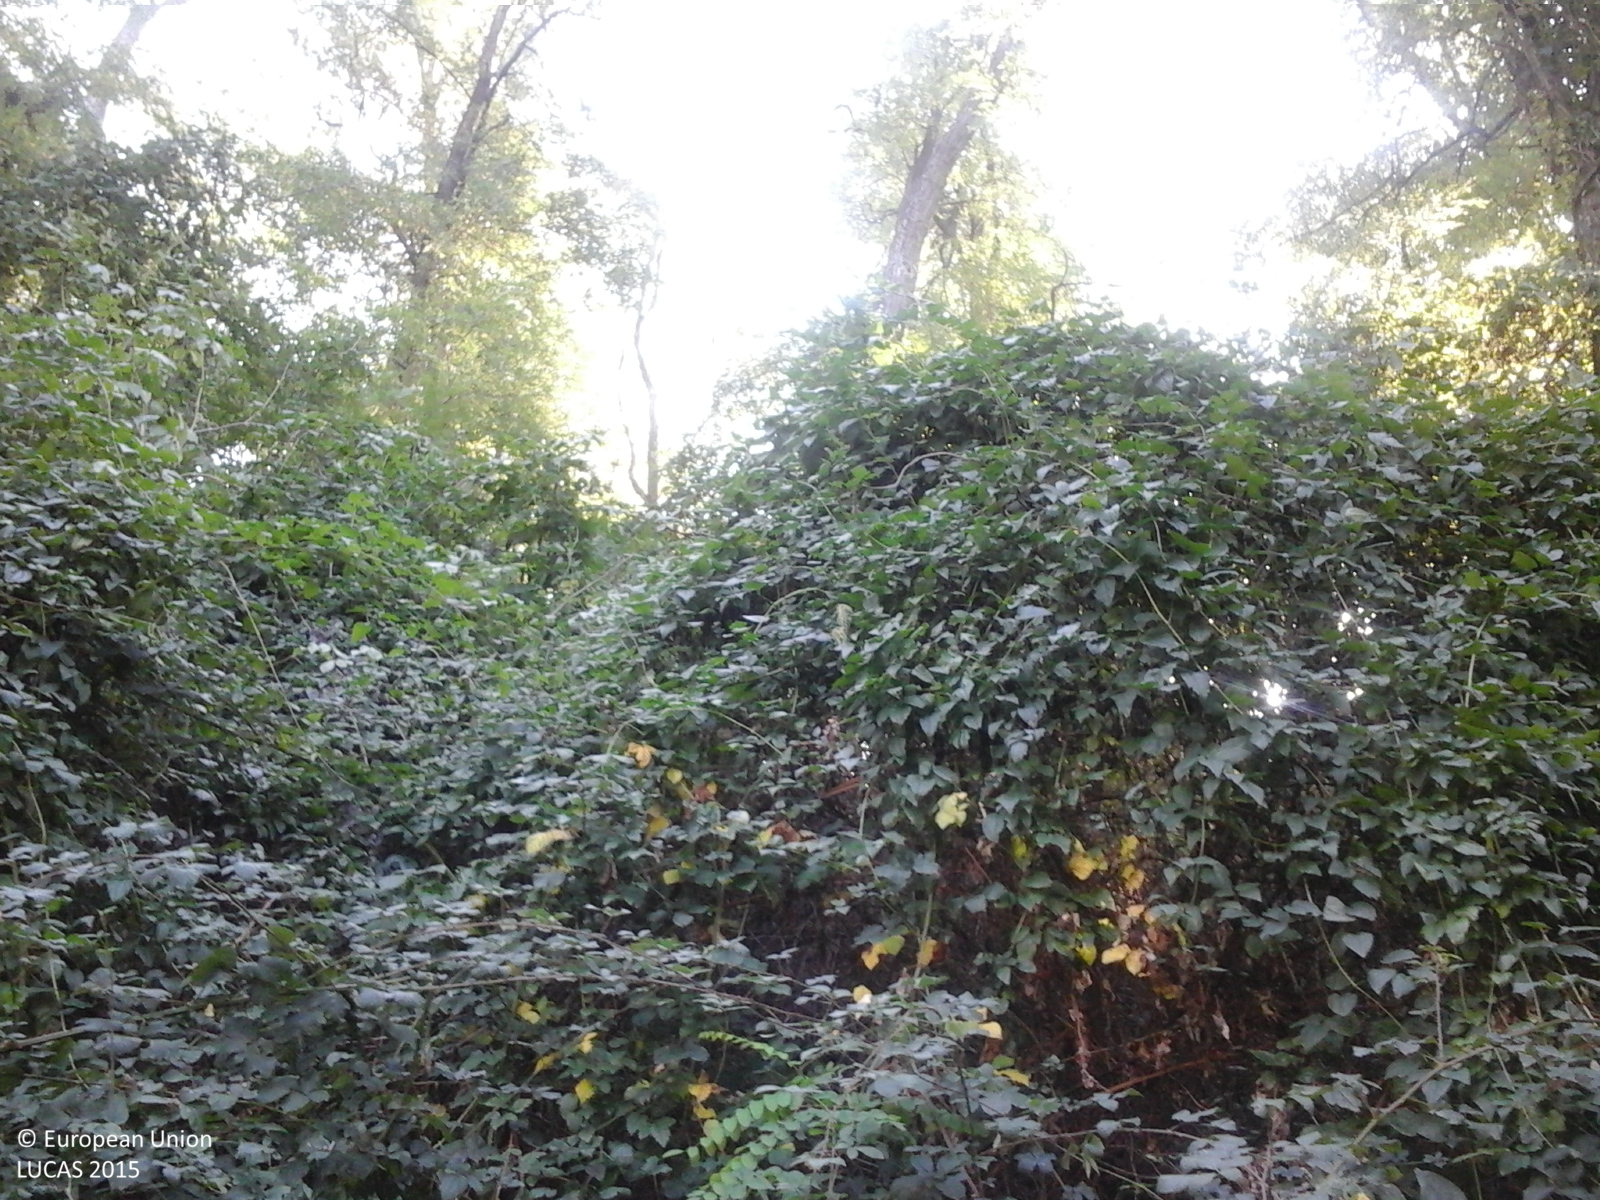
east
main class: Woodland
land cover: Broadleaved woodland
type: exotic forest
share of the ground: > 75 %
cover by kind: broadleaved forest trees 100 %
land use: Forestry
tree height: > 5 m
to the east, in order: Broadleaved woodland; Grassland without tree/shrub cover; Tracks; Broadleaved woodland; Grassland with sparse tree/shrub cover; Permanent crops (only in case pi); Broadleaved woodland
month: September
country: RO
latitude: 45.0887
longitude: 22.3264
